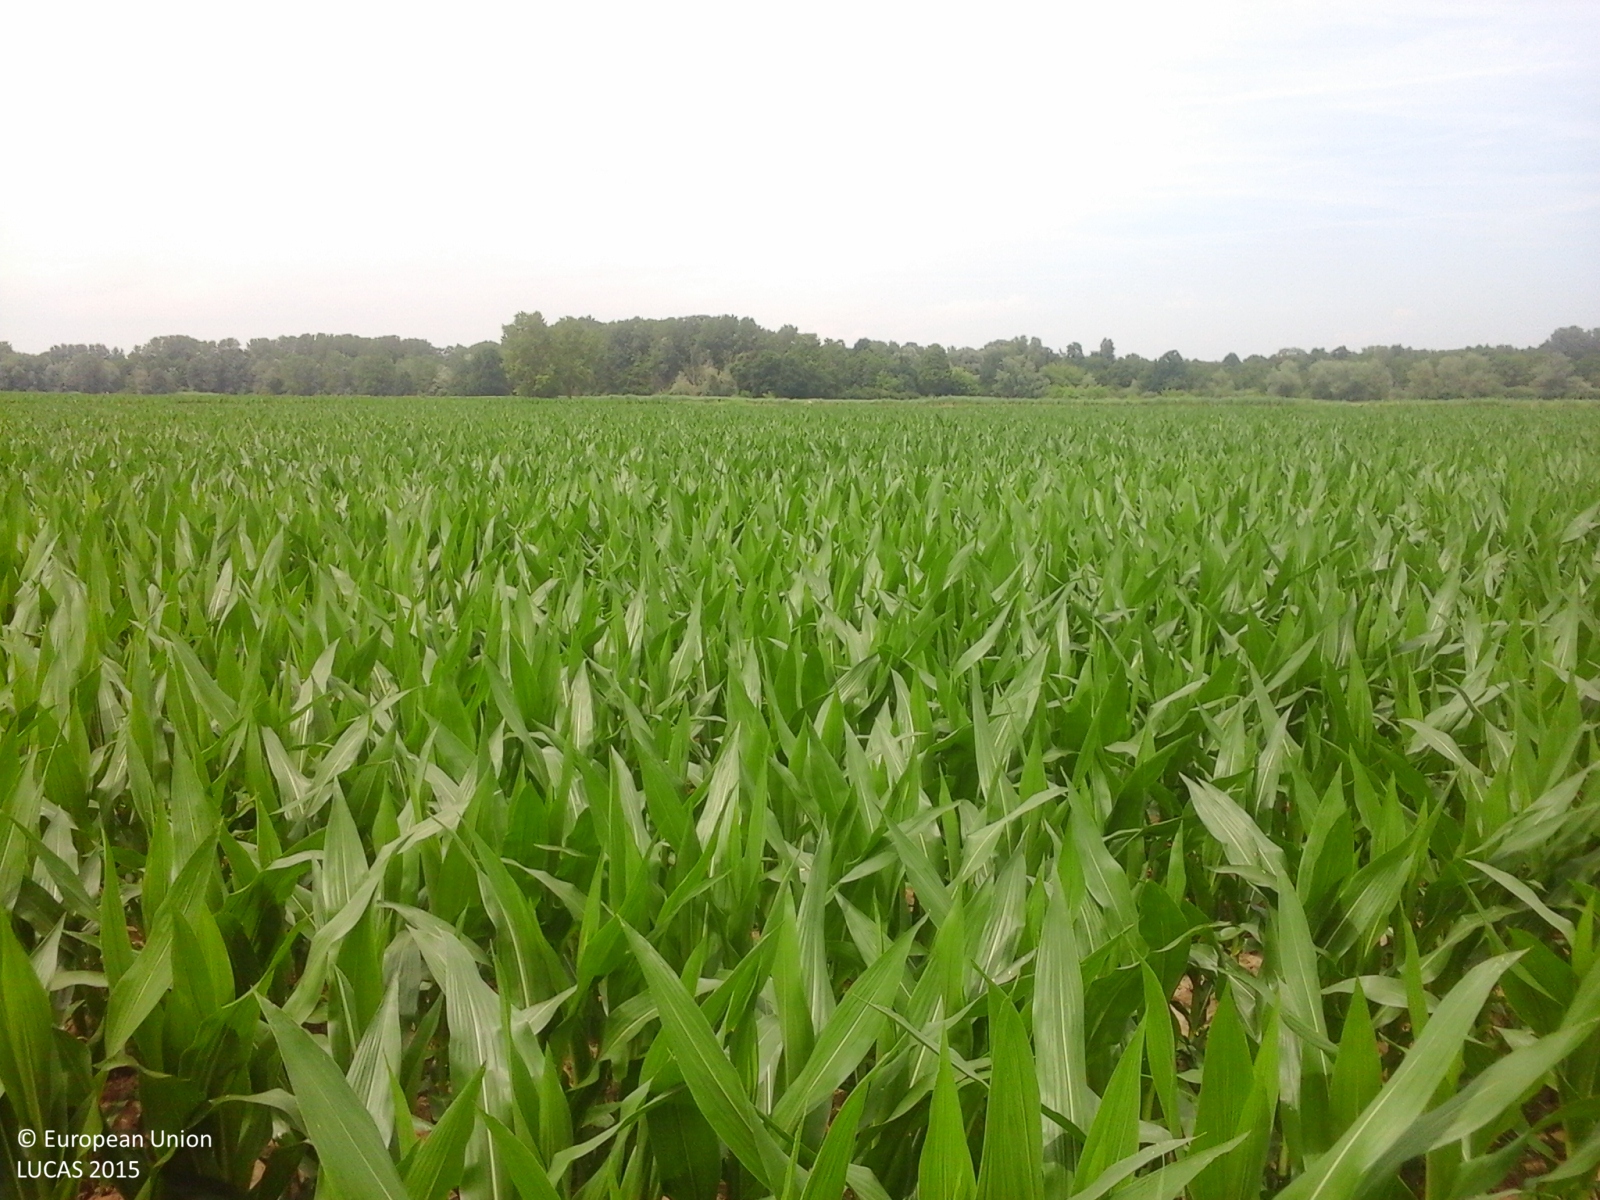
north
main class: Cropland
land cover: Maize
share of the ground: > 75 %
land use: Agriculture (excluding fallow land and kitchen gardens)
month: June
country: IT
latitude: 45.0640
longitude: 8.7197
